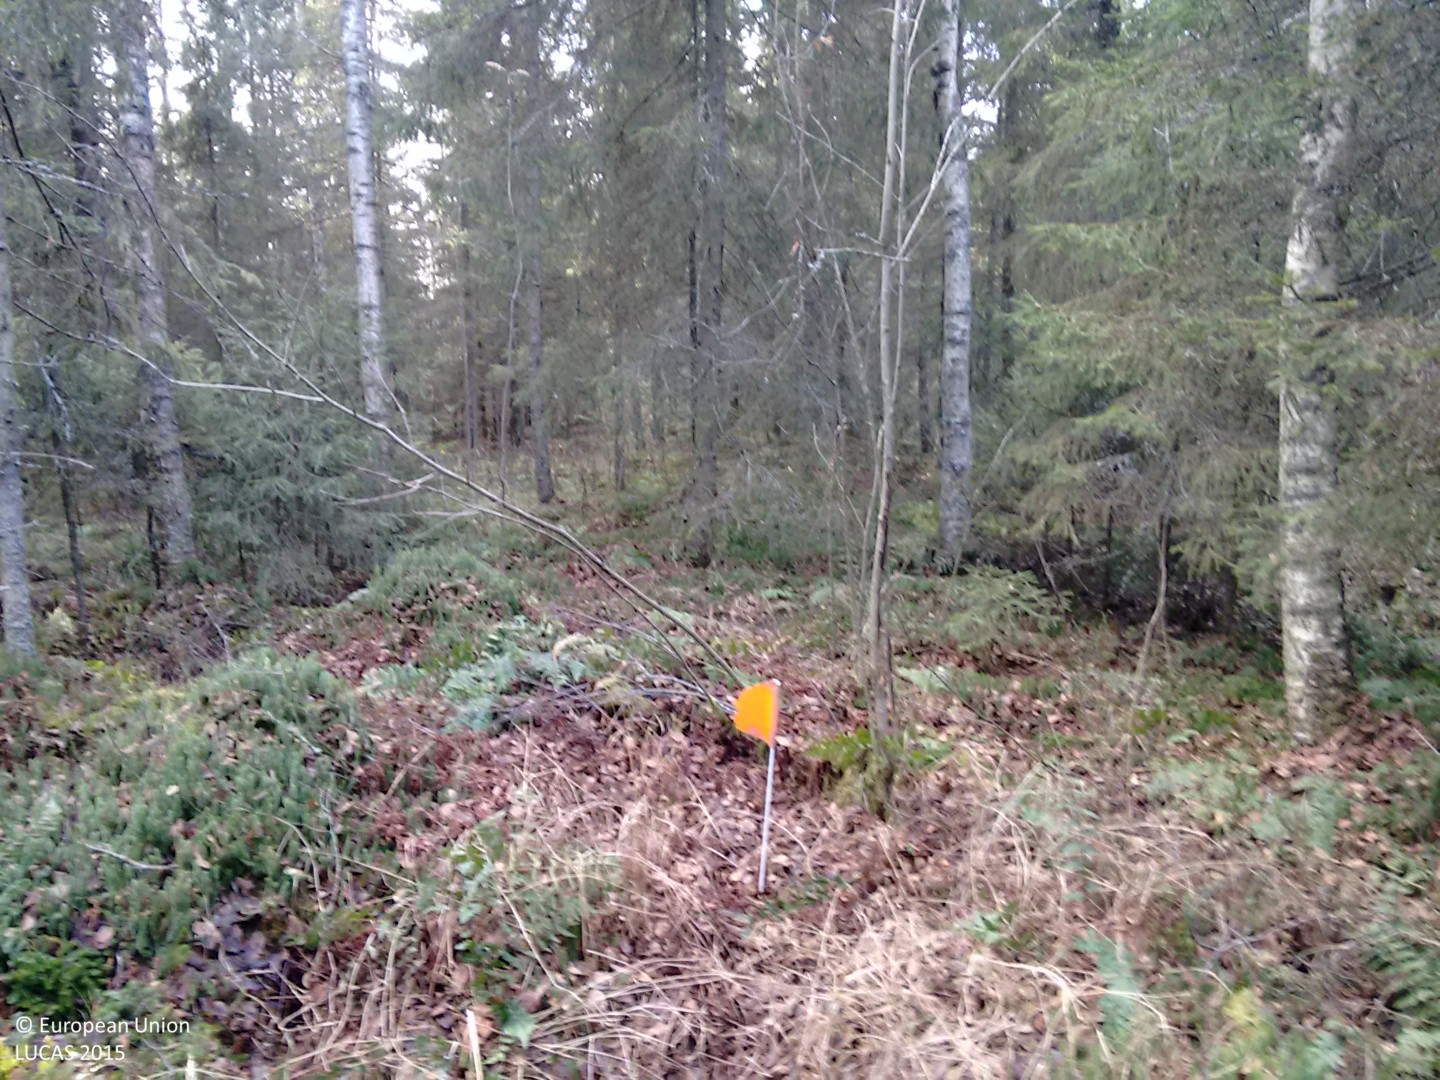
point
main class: Woodland
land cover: Spruce dominated mixed woodland
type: boreal forest
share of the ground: > 75 %
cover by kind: coniferous forest trees 60 %, broadleaved forest trees 25 %, herbaceous plants 10 %, shrubs 5 %
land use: Forestry
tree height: > 5 m
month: October
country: FI
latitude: 63.9186
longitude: 25.1964
